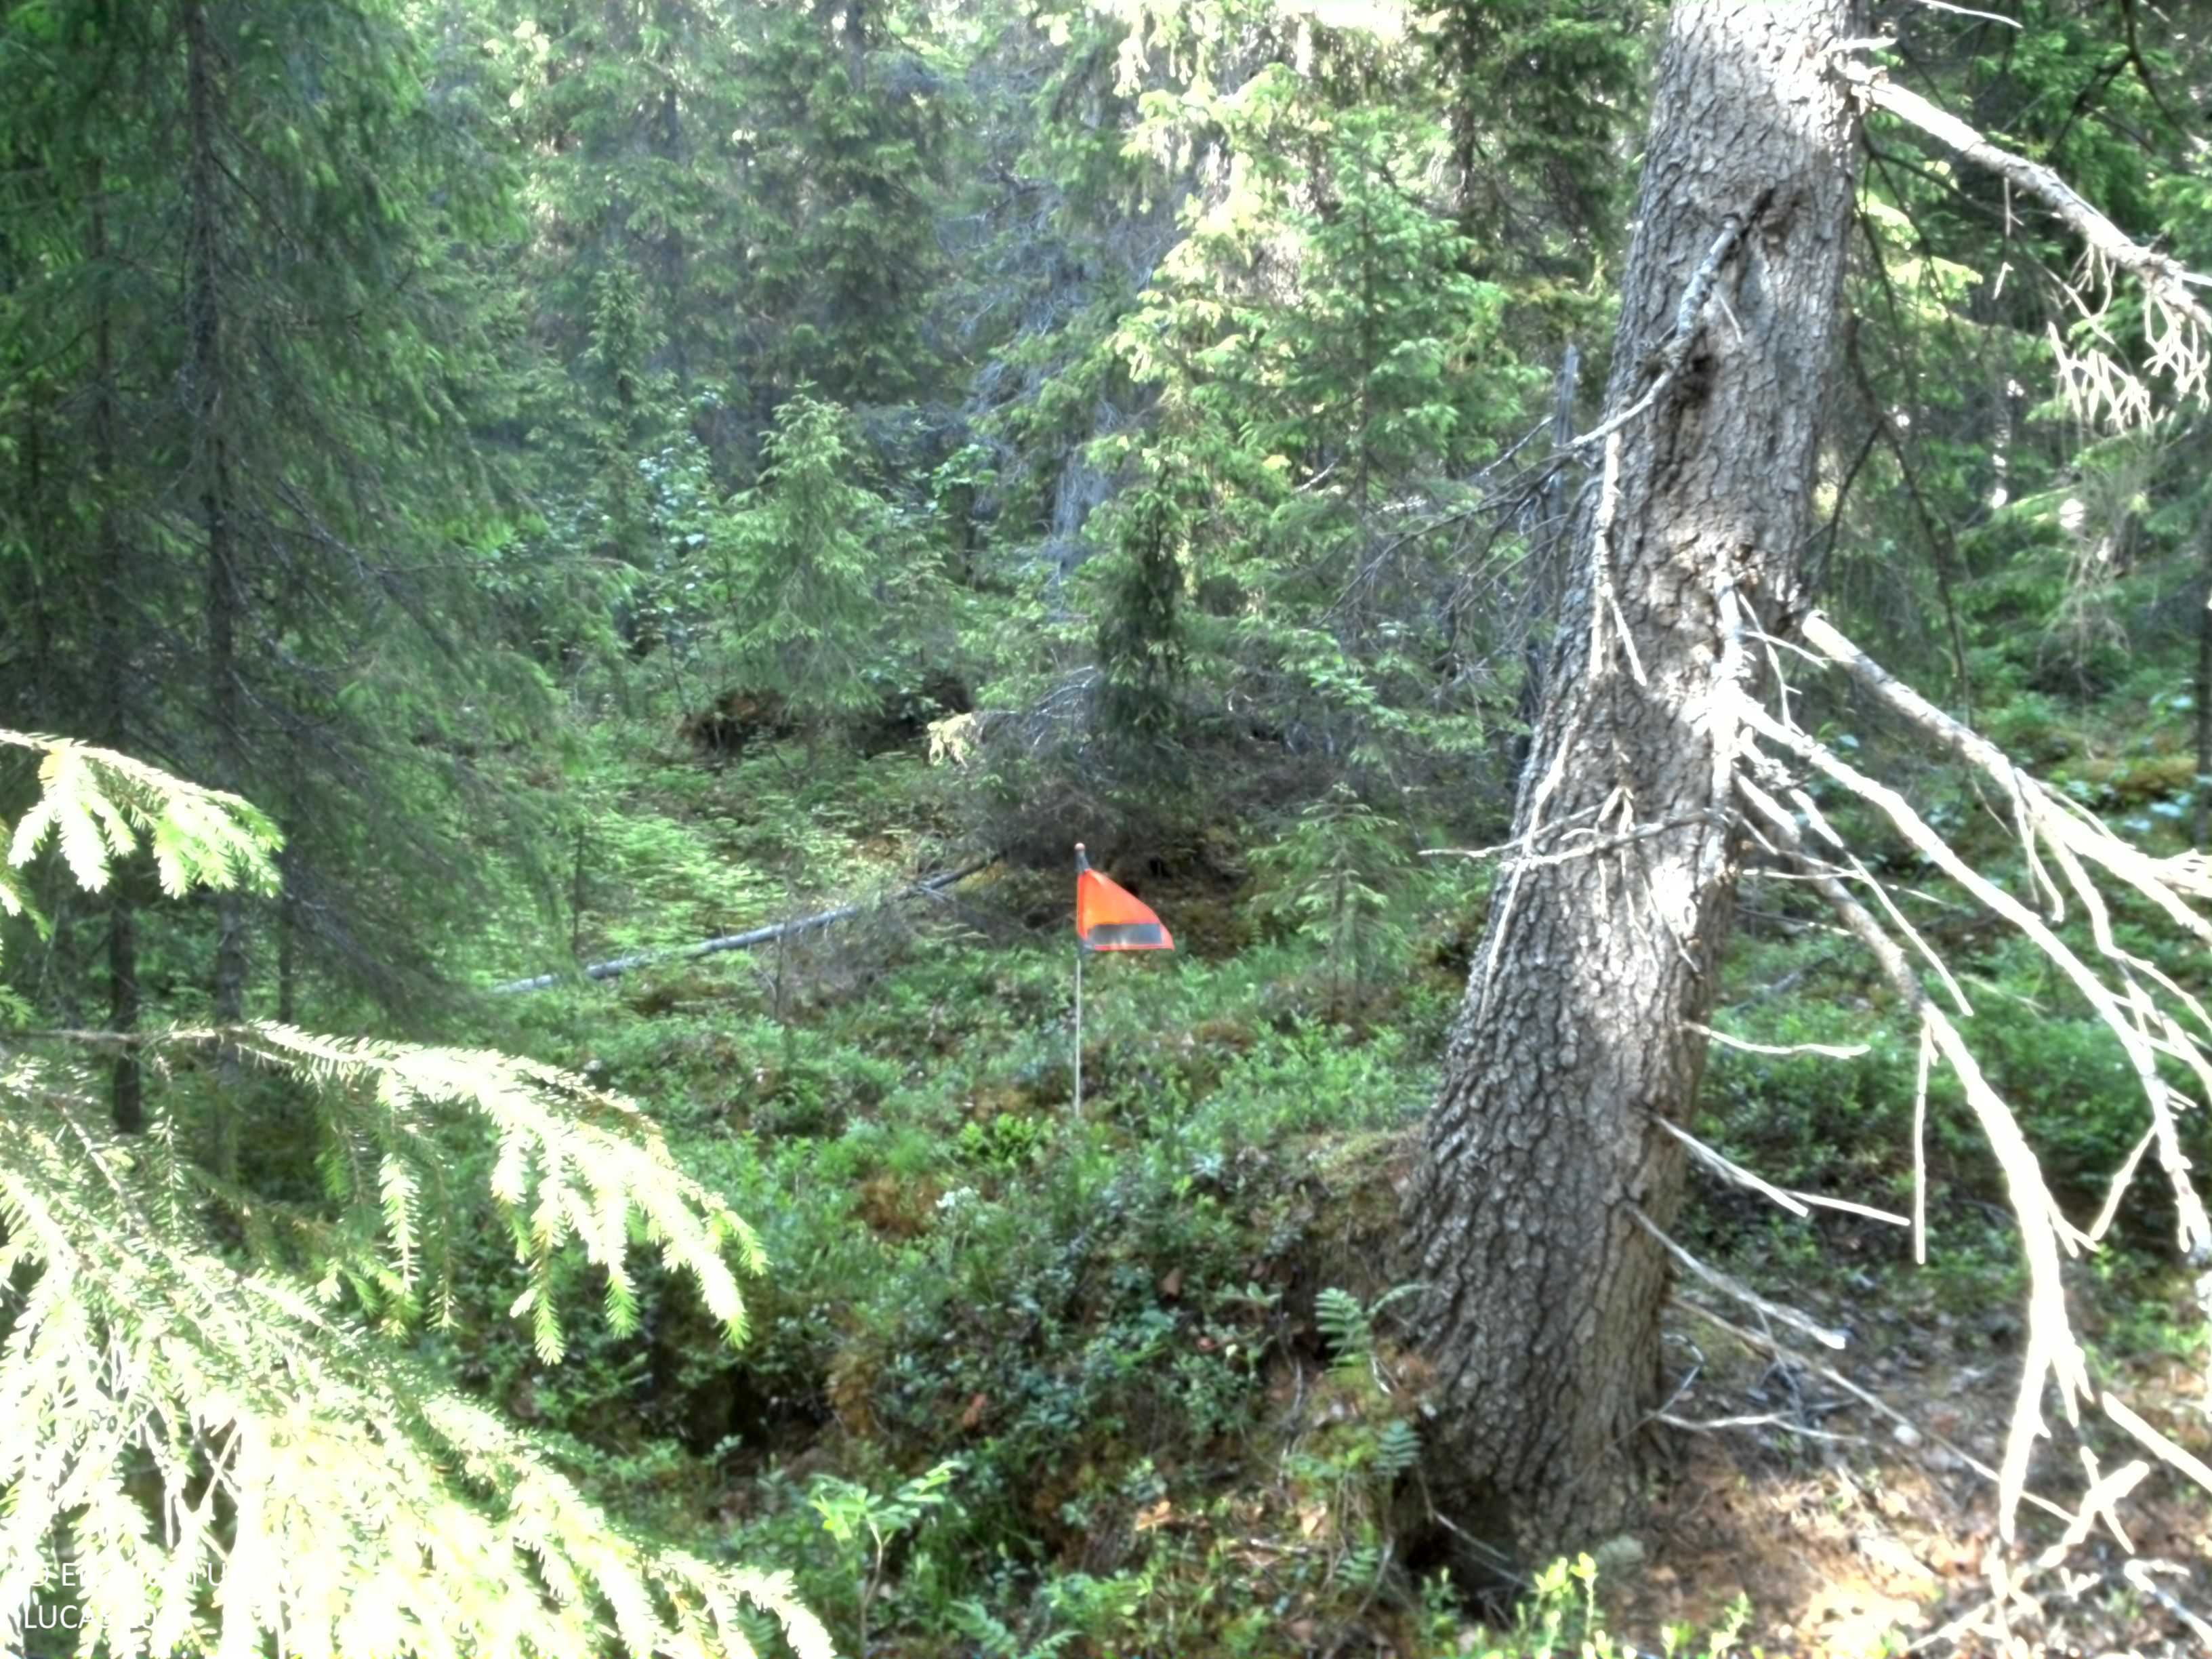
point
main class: Woodland
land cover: Spruce dominated coniferous woodland
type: boreal forest
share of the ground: 25 - 50 %
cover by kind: coniferous forest trees 40 %, shrubs 30 %, lichens and mosses 15 %, herbaceous plants 10 %, broadleaved forest trees 5 %
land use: Forestry
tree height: > 5 m
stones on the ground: < 10 %
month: July
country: SE
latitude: 65.5559
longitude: 15.4008
